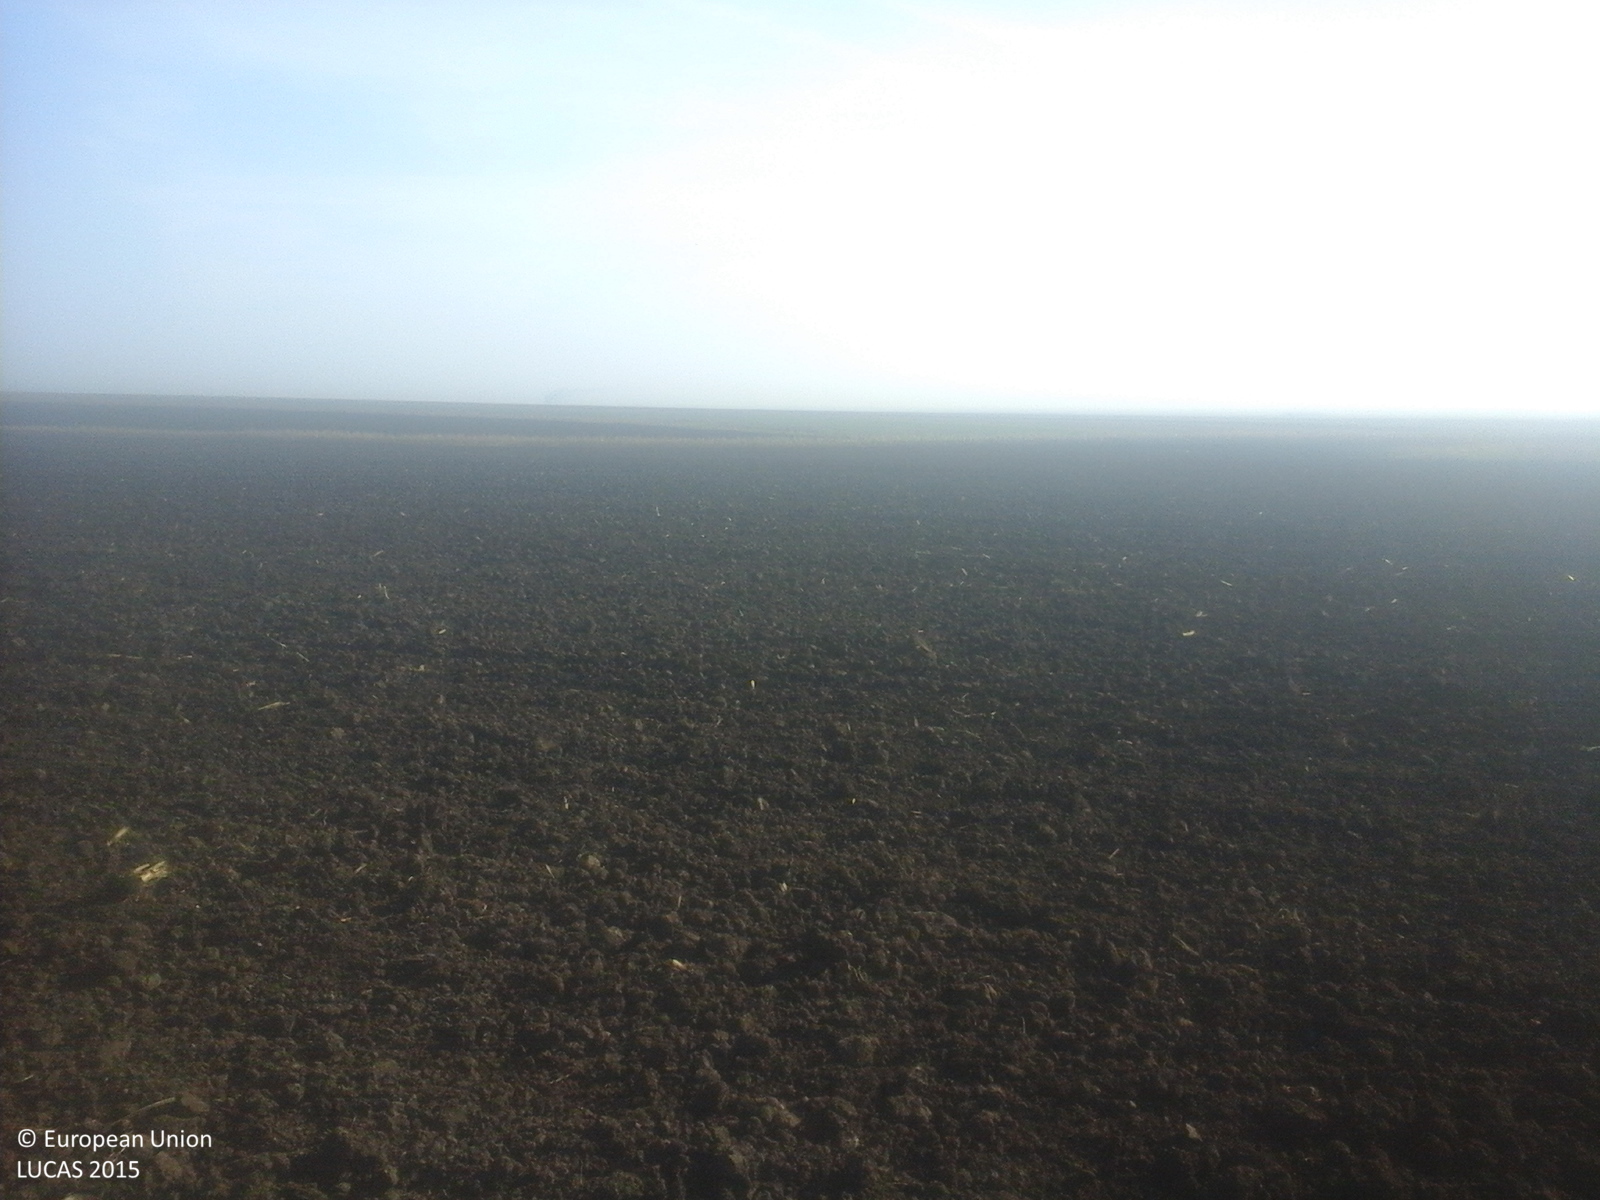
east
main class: Cropland
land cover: Common wheat
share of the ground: < 10 %
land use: Agriculture (excluding fallow land and kitchen gardens)
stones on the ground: < 10 %
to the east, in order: Common wheat; Other bare soil; Maize; Sunflower; Common wheat
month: October
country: RO
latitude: 45.2530
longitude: 26.8894
